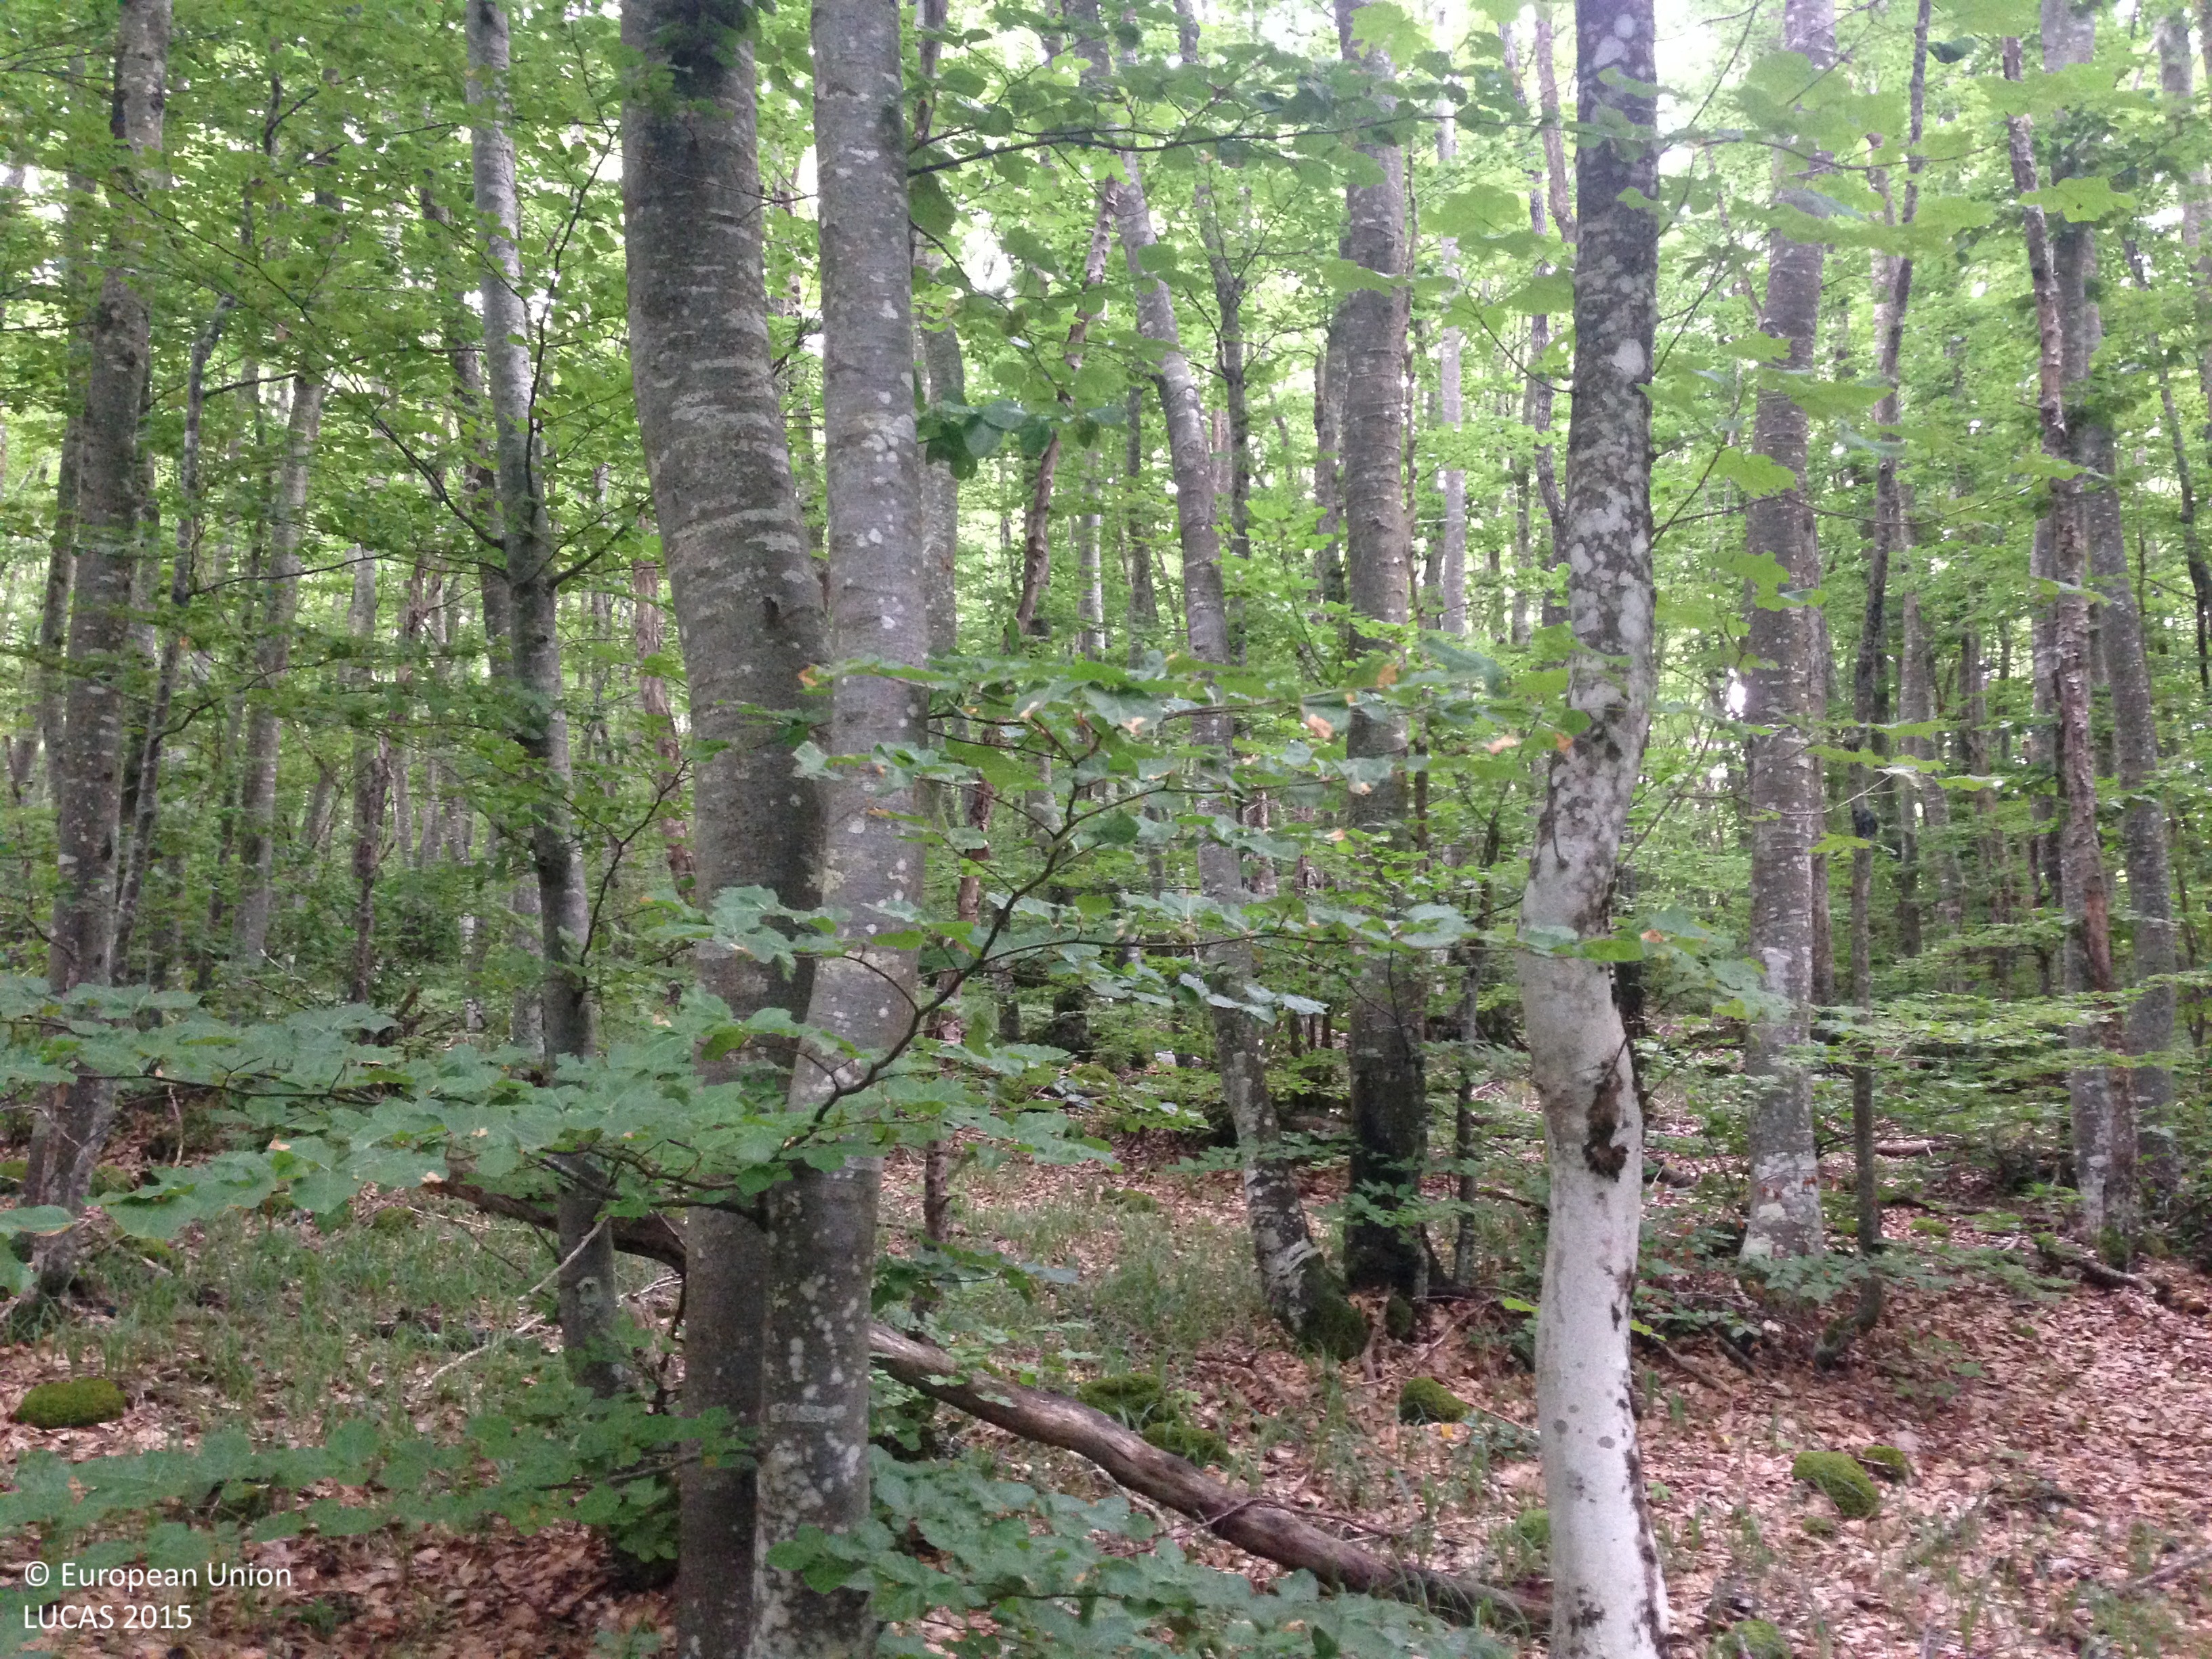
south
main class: Woodland
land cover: Broadleaved woodland
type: mountainous beech forest
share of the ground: > 75 %
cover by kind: broadleaved forest trees 80 %, shrubs 10 %, herbaceous plants 5 %, consolidated bare surface 5 %
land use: Forestry
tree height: > 5 m
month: June
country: HR
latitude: 44.6994
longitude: 15.7110
